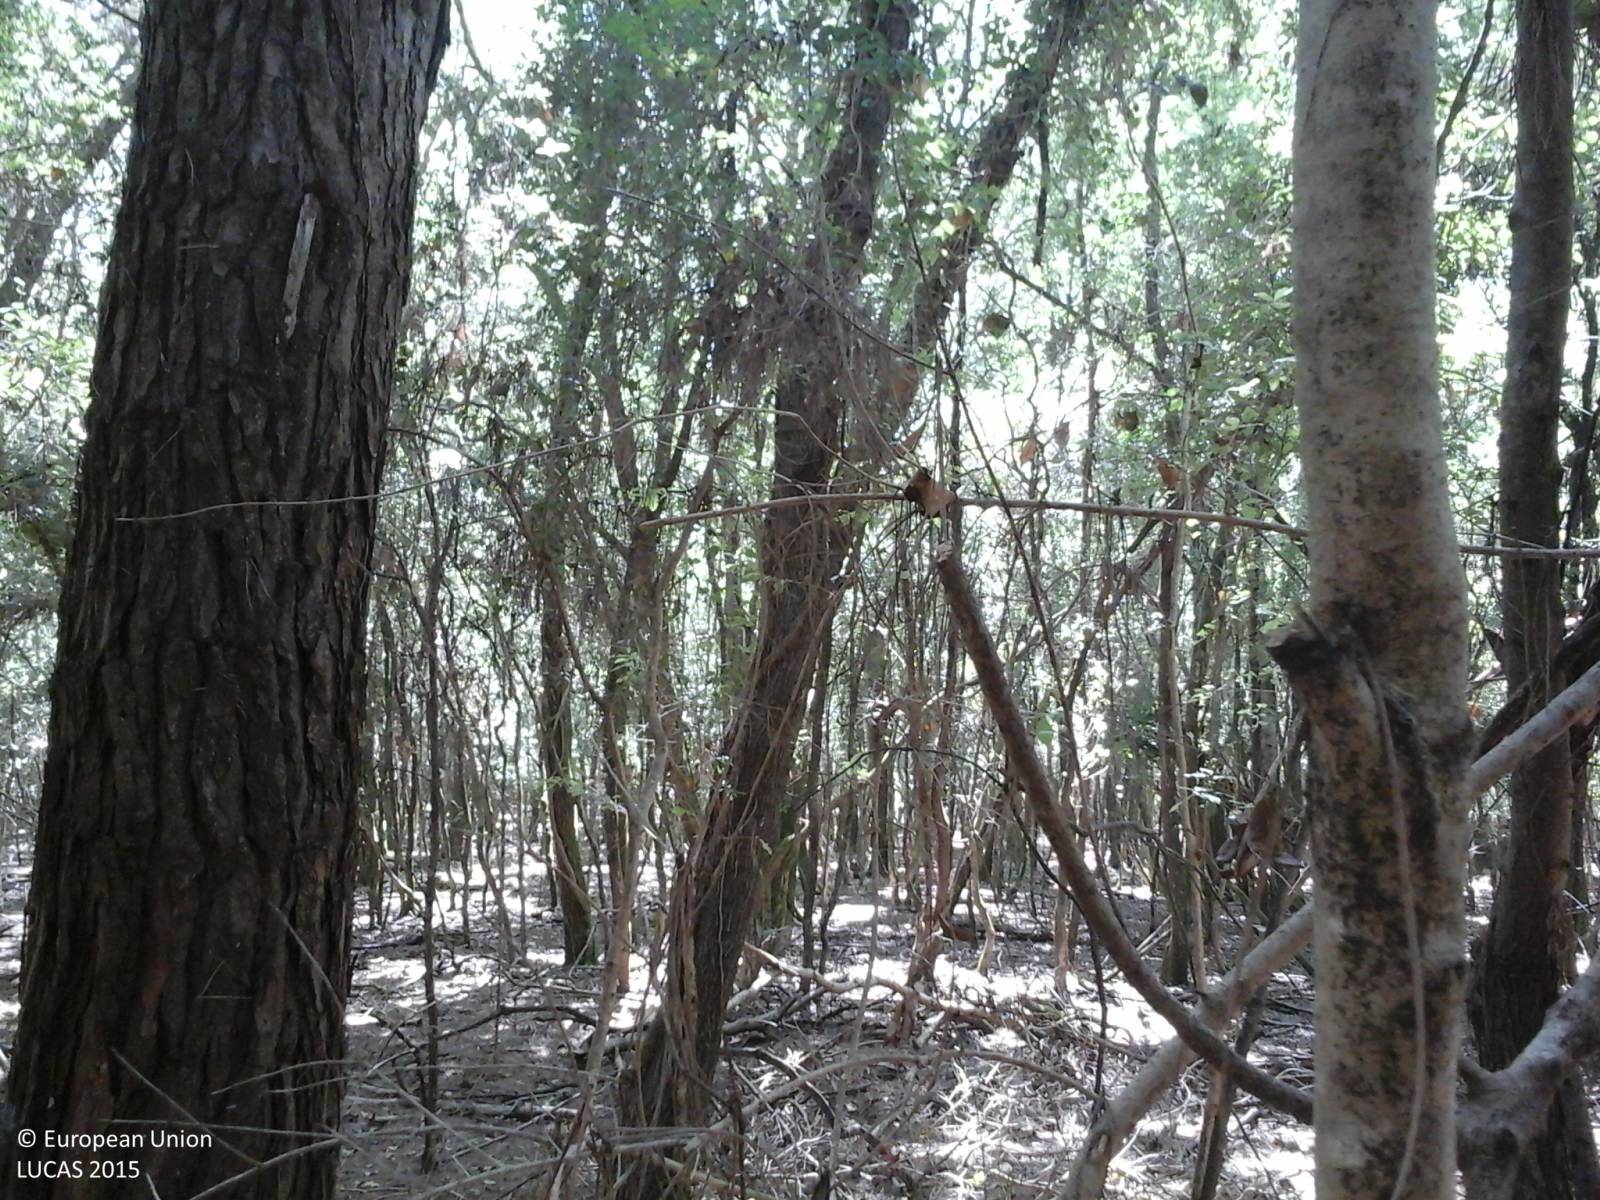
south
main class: Woodland
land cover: Pine dominated mixed woodland
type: coniferous forest of the mediterranean region
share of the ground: > 75 %
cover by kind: coniferous forest trees 75 %, broadleaved forest trees 25 %
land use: Semi-natural and natural areas not in use
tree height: > 5 m
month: August
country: IT
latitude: 41.3059
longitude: 13.0571
